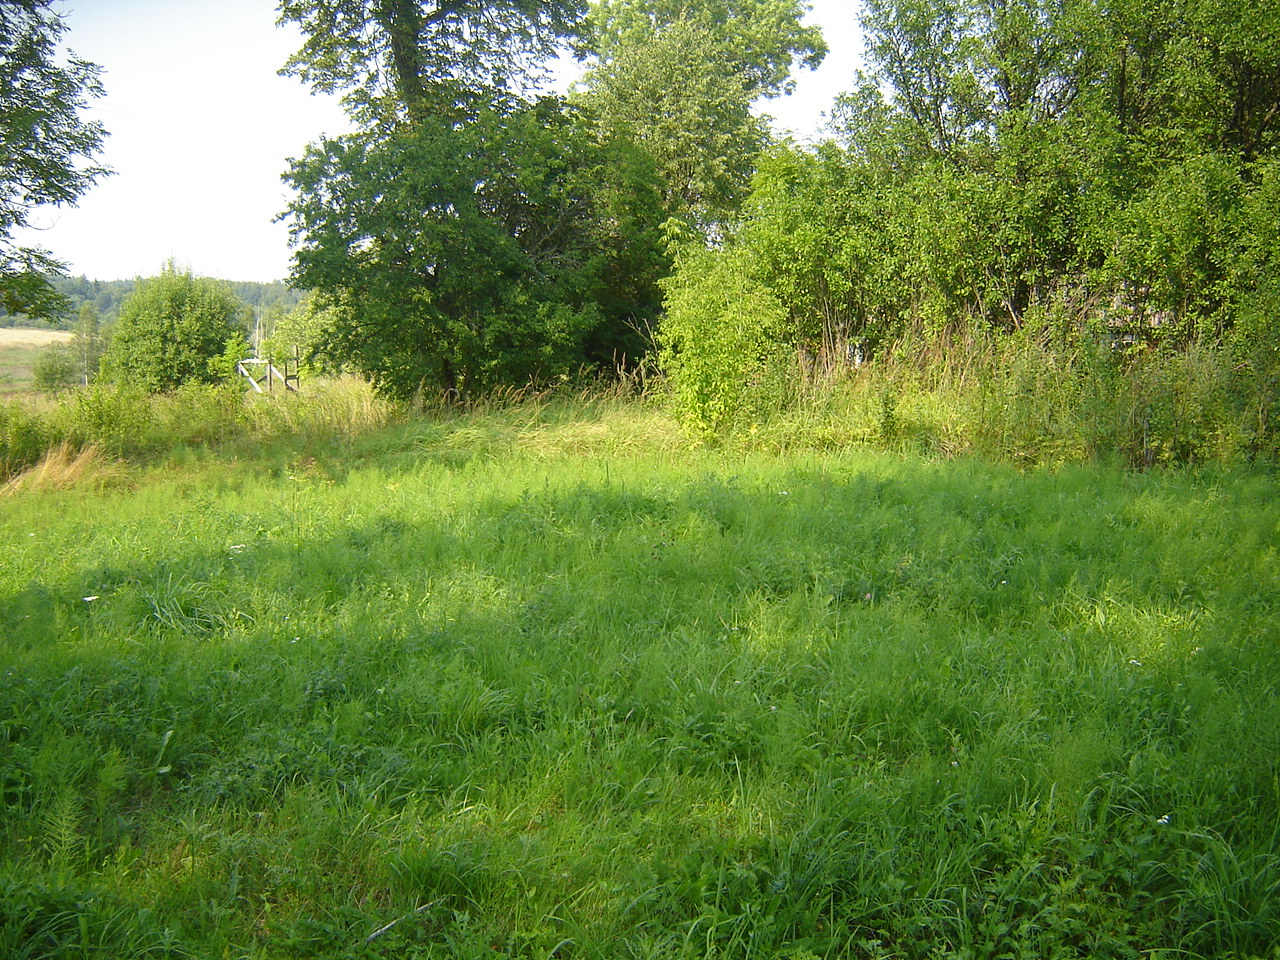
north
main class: Grassland
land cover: Grassland with sparse tree/shrub cover
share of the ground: > 75 %
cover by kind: herbaceous plants 95 %, broadleaved forest trees 5 %
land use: Agriculture (excluding fallow land and kitchen gardens)
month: August
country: LT
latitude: 54.8712
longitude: 24.8997
